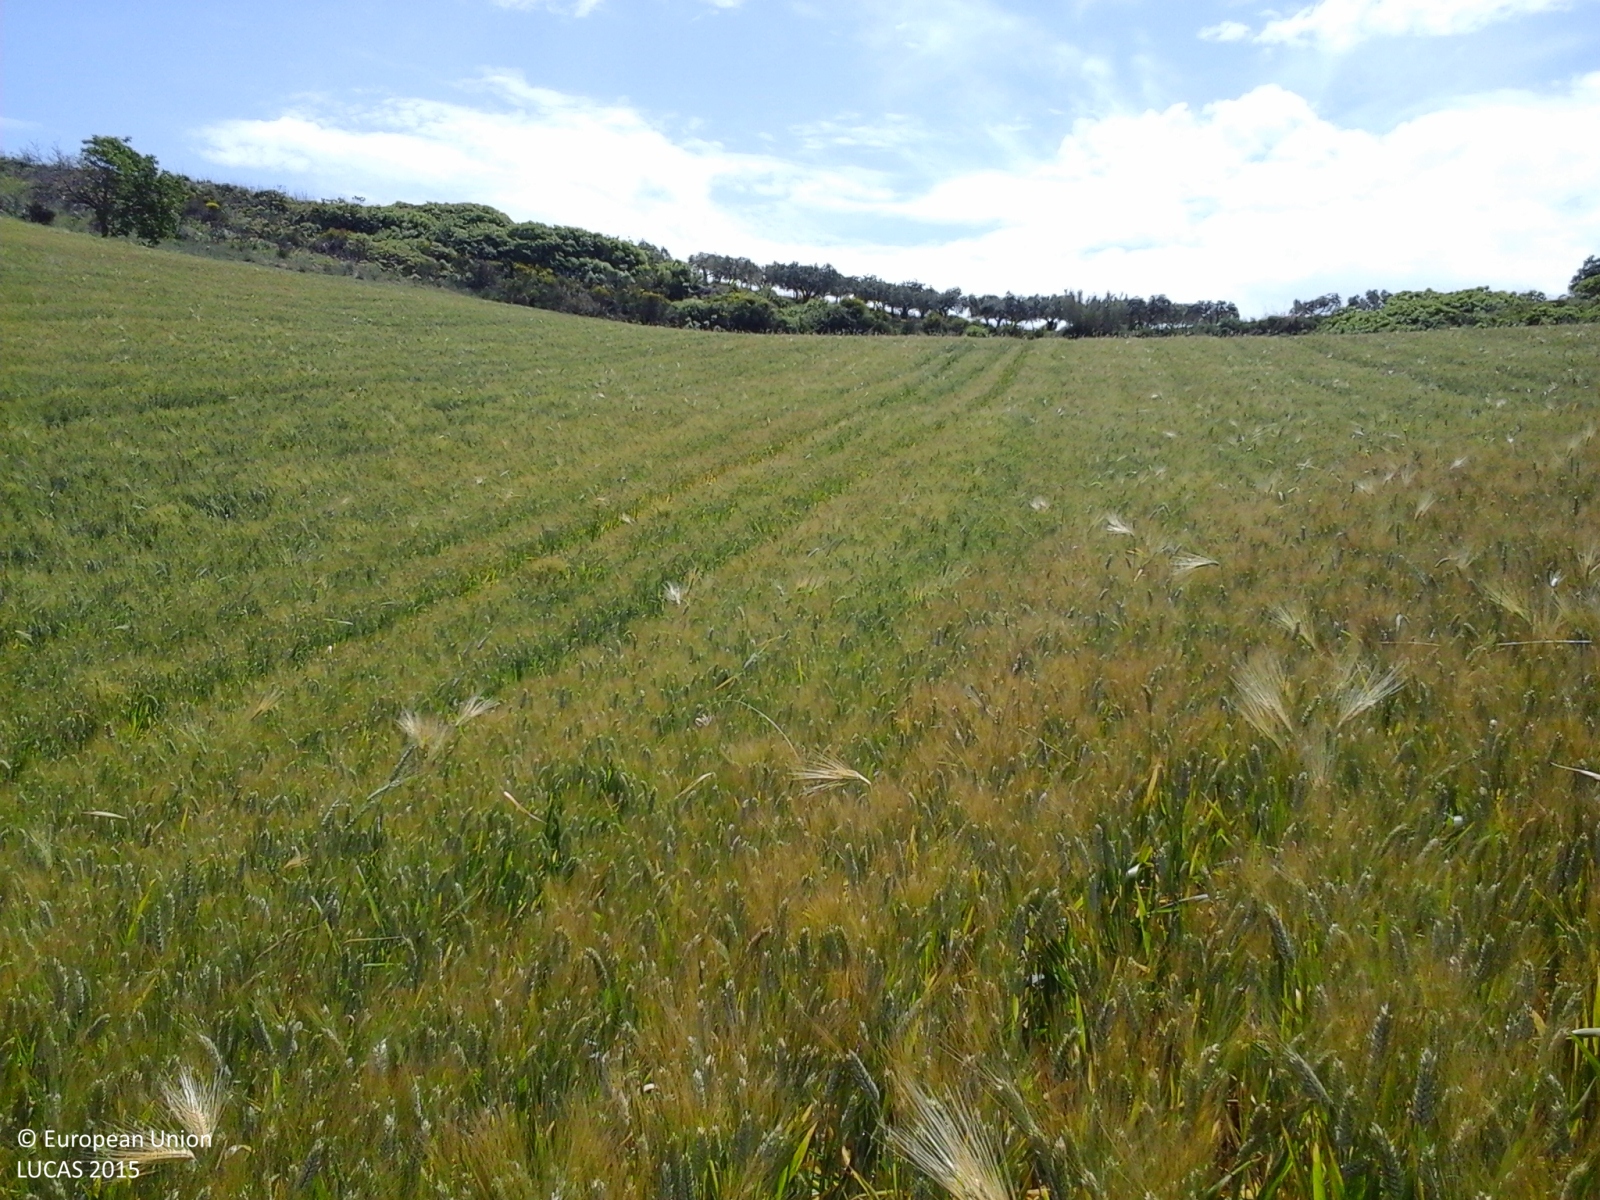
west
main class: Cropland
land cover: Durum wheat
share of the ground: > 75 %
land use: Agriculture (excluding fallow land and kitchen gardens)
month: May
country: IT
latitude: 37.8809
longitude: 13.5558
